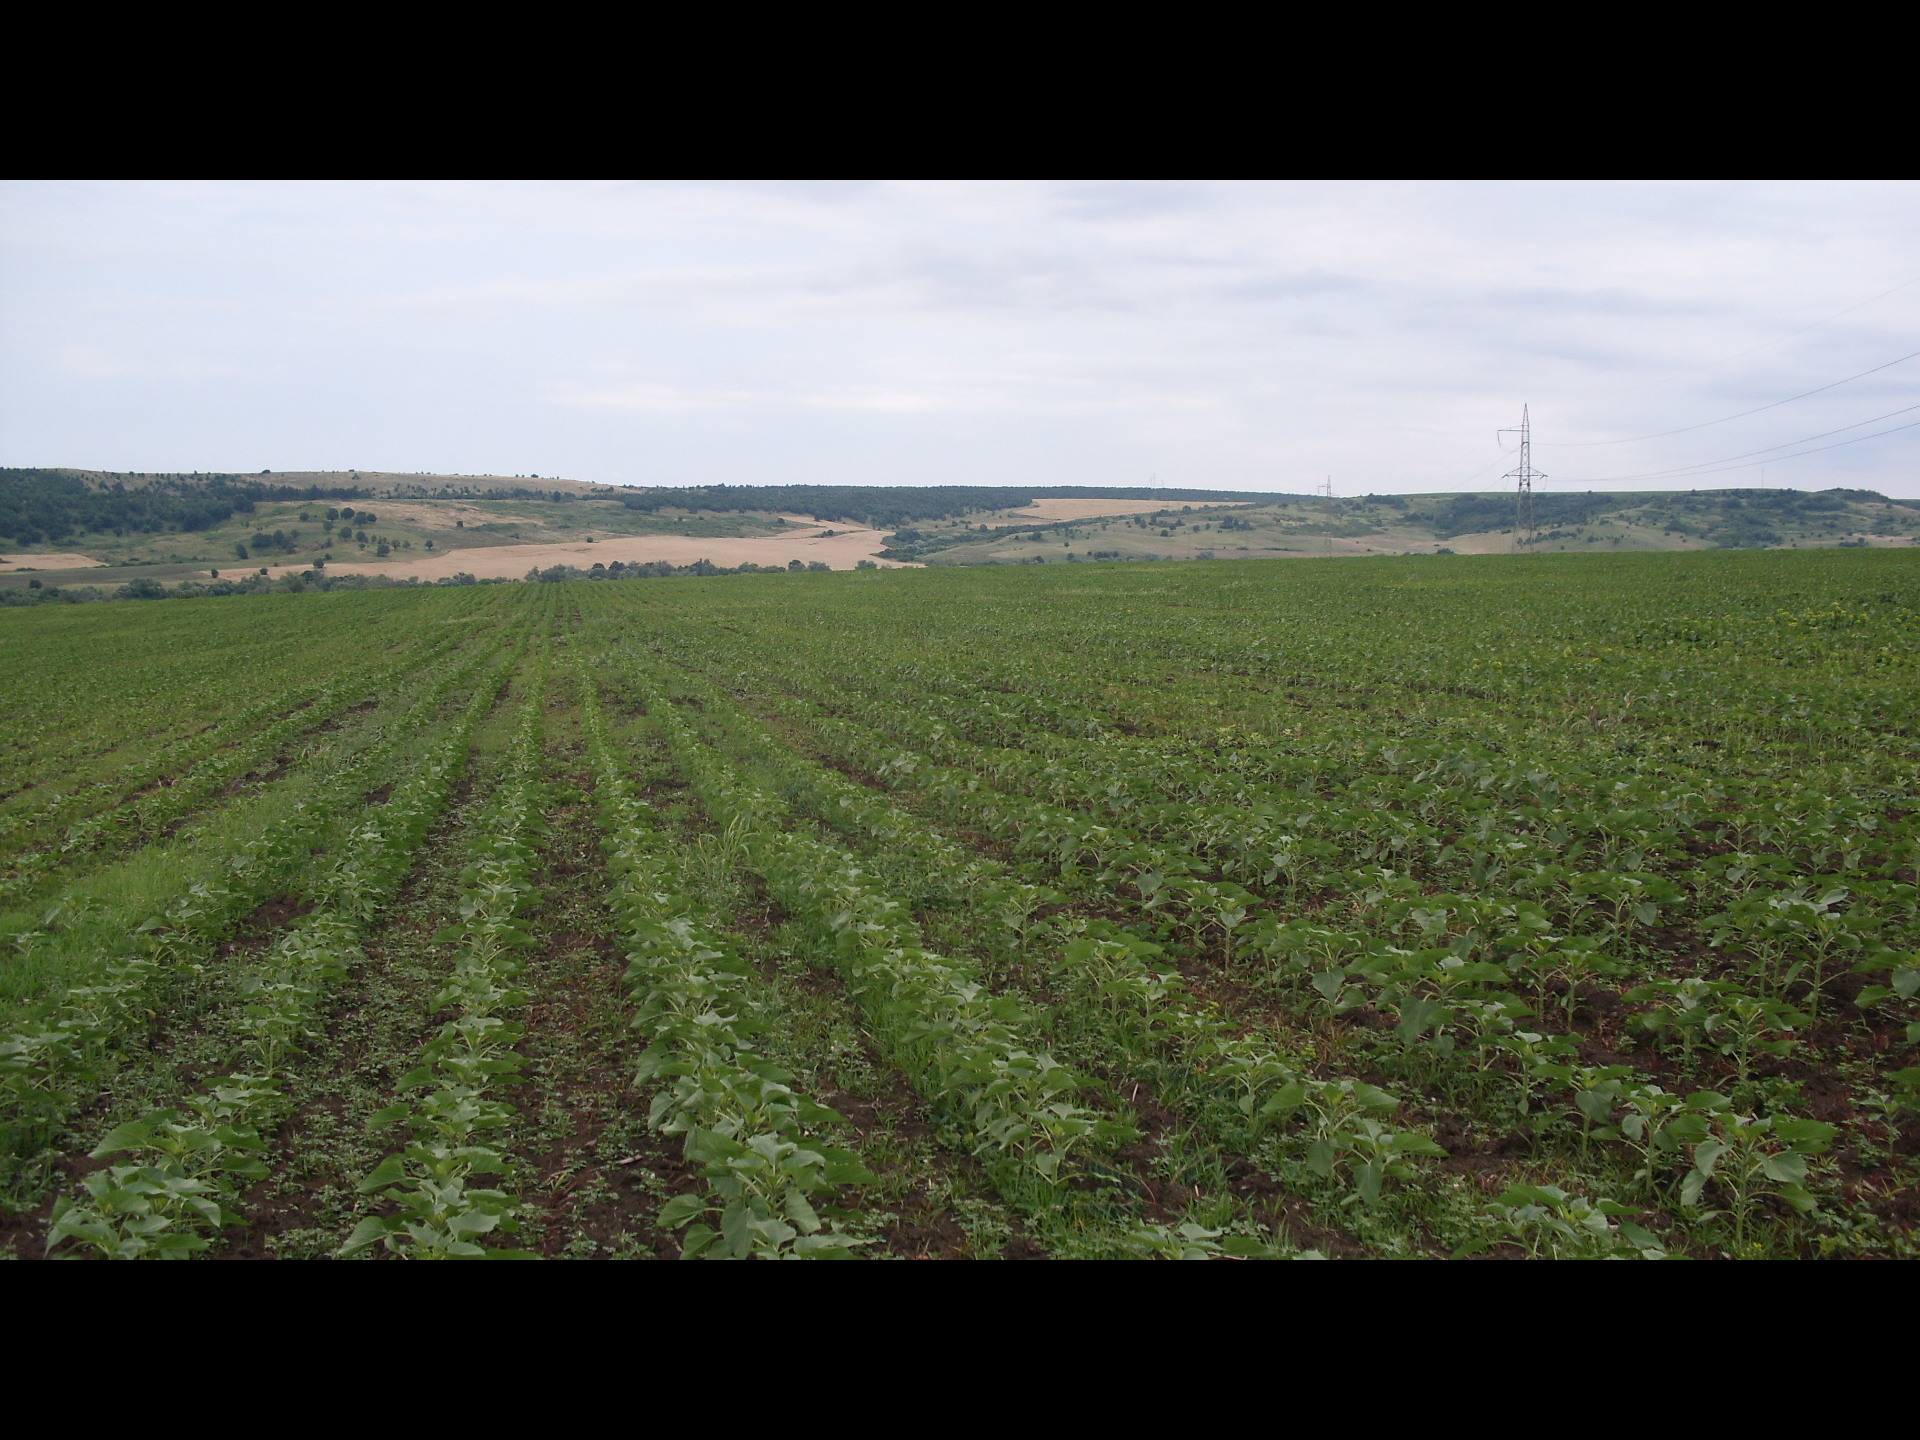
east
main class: Cropland
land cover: Sunflower
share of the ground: 25 - 50 %
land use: Agriculture (excluding fallow land and kitchen gardens)
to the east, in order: Sunflower
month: June
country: BG
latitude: 43.4422
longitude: 23.5245
